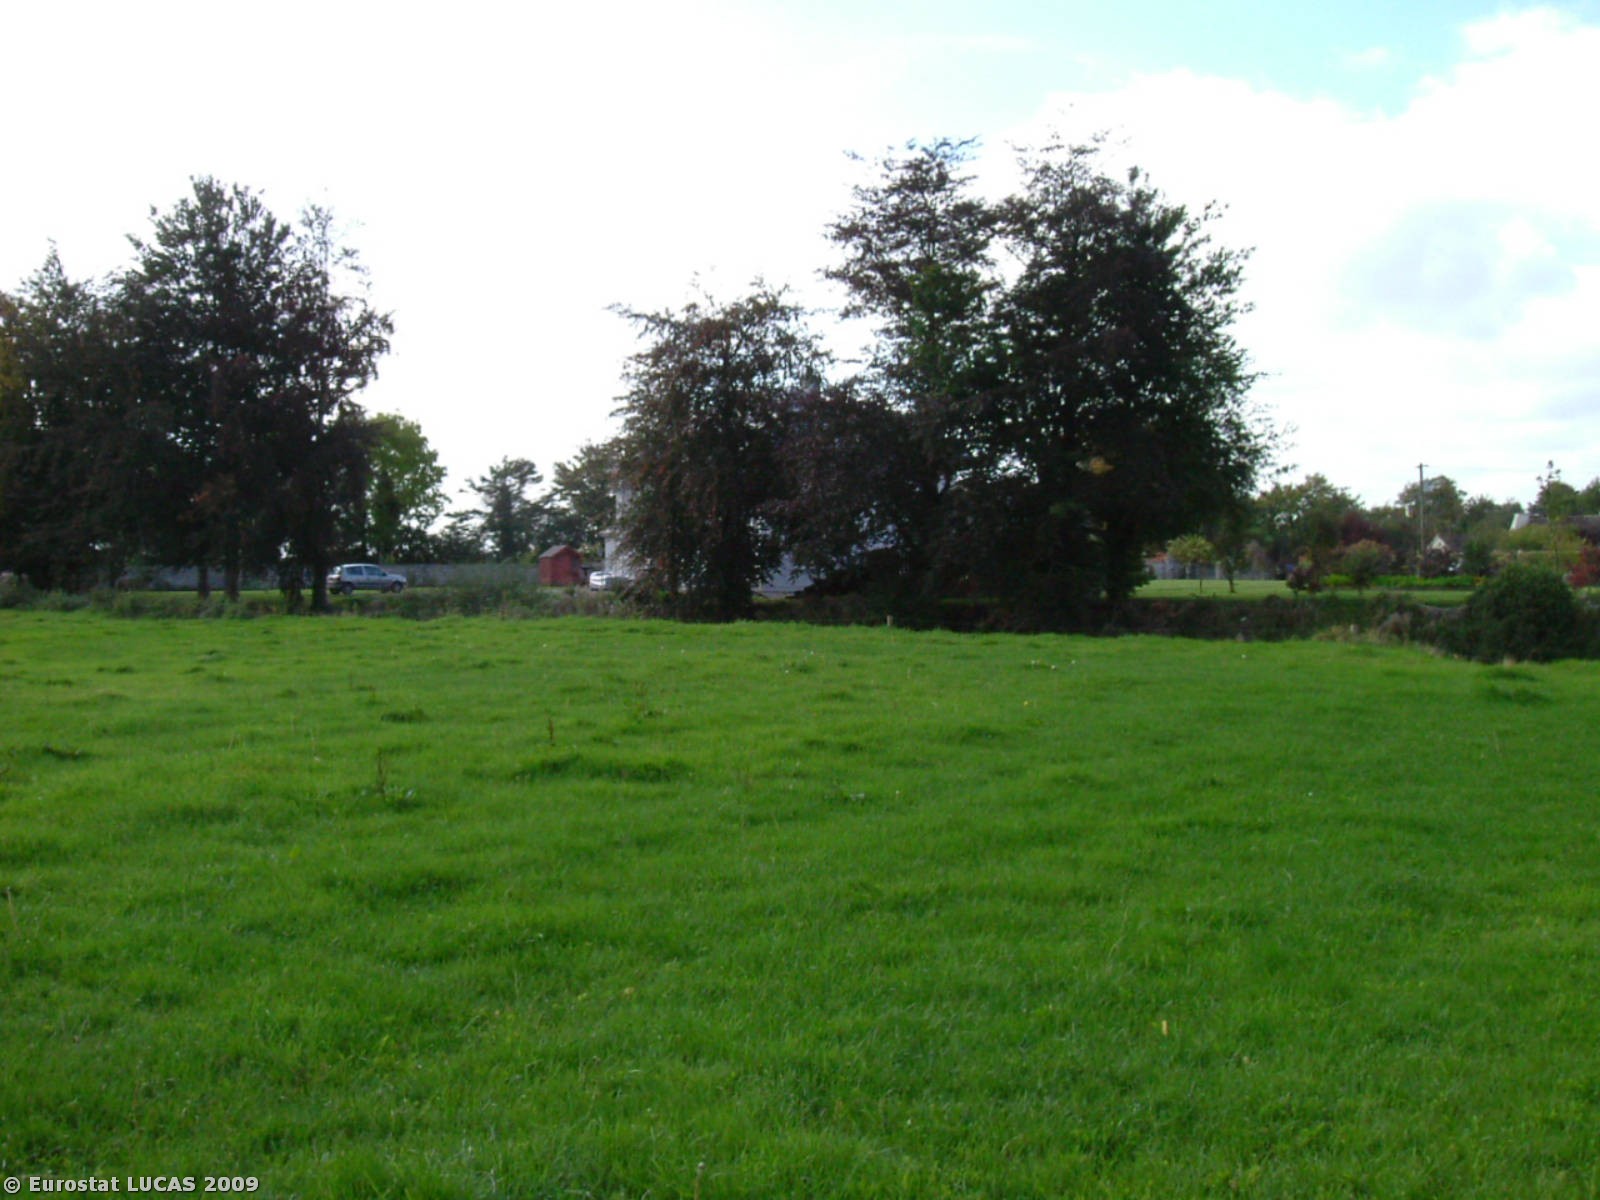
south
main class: Grassland
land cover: Grassland without tree/shrub cover
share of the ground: > 75 %
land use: Agriculture (excluding fallow land and kitchen gardens)
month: September
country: IE
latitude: 52.8038
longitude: -7.8060
